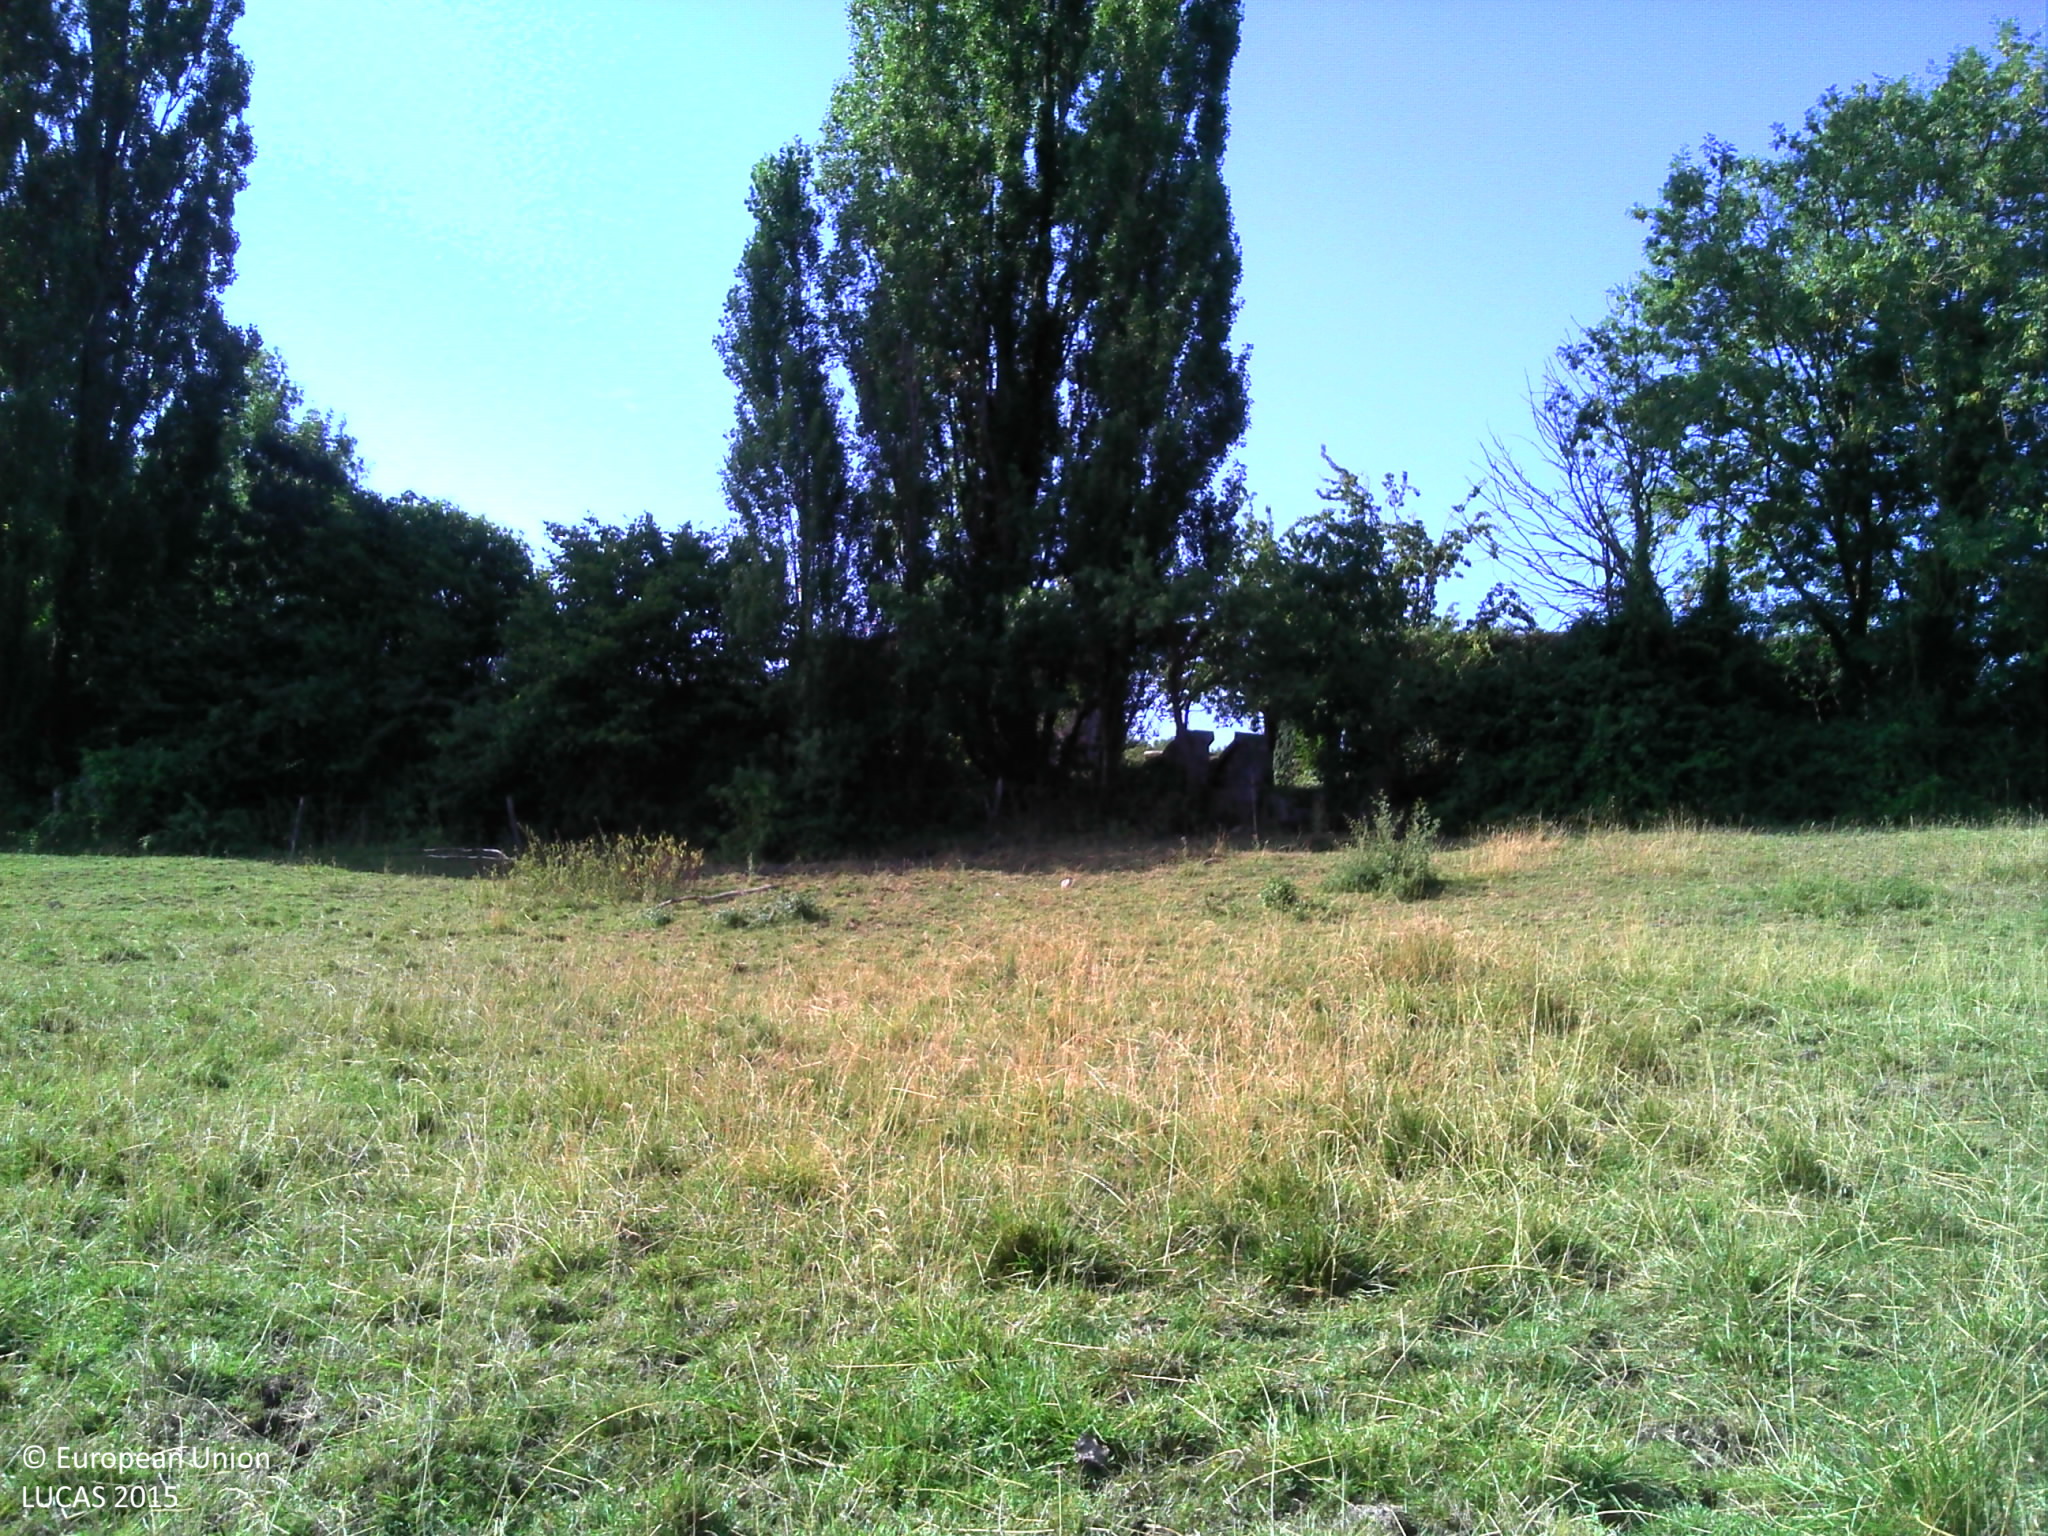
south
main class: Grassland
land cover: Grassland without tree/shrub cover
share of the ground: > 75 %
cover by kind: herbaceous plants 85 %, unconsolidated bare surface 10 %
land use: Agriculture (excluding fallow land and kitchen gardens)
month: August
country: FR
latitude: 48.7874
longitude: 3.7744
